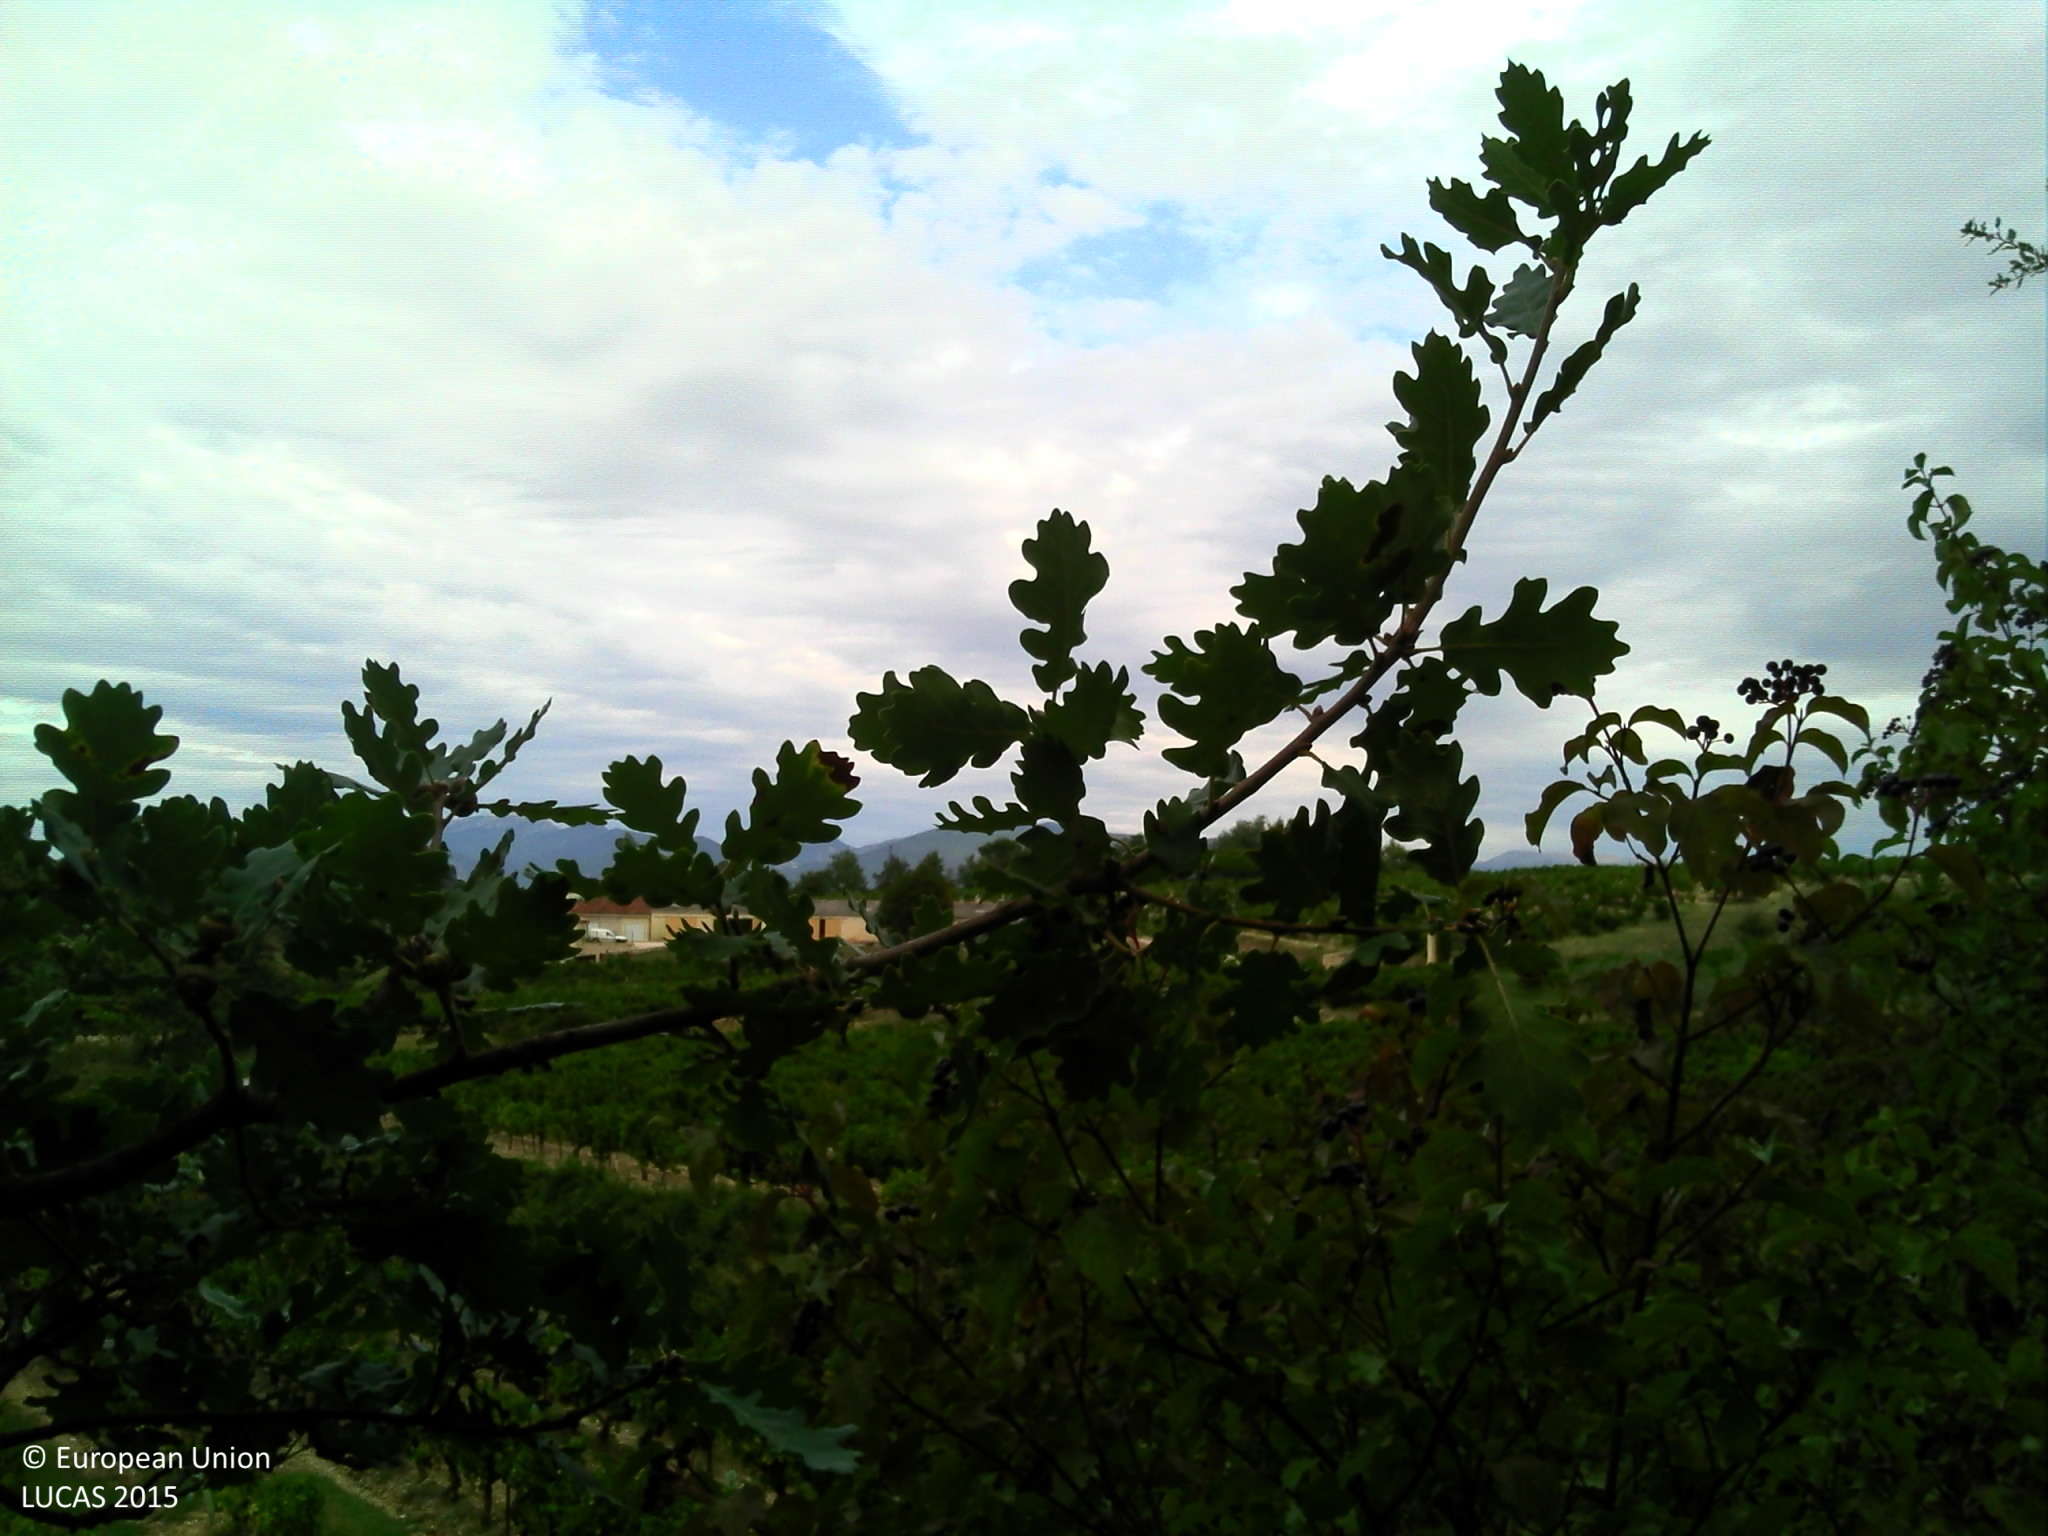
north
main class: Woodland
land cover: Broadleaved woodland
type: thermophilous deciduous forest
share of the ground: > 75 %
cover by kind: broadleaved forest trees 90 %, coniferous forest trees 5 %, herbaceous plants 5 %
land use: Forestry
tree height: > 5 m
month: September
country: FR
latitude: 44.3062
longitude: 5.0811
